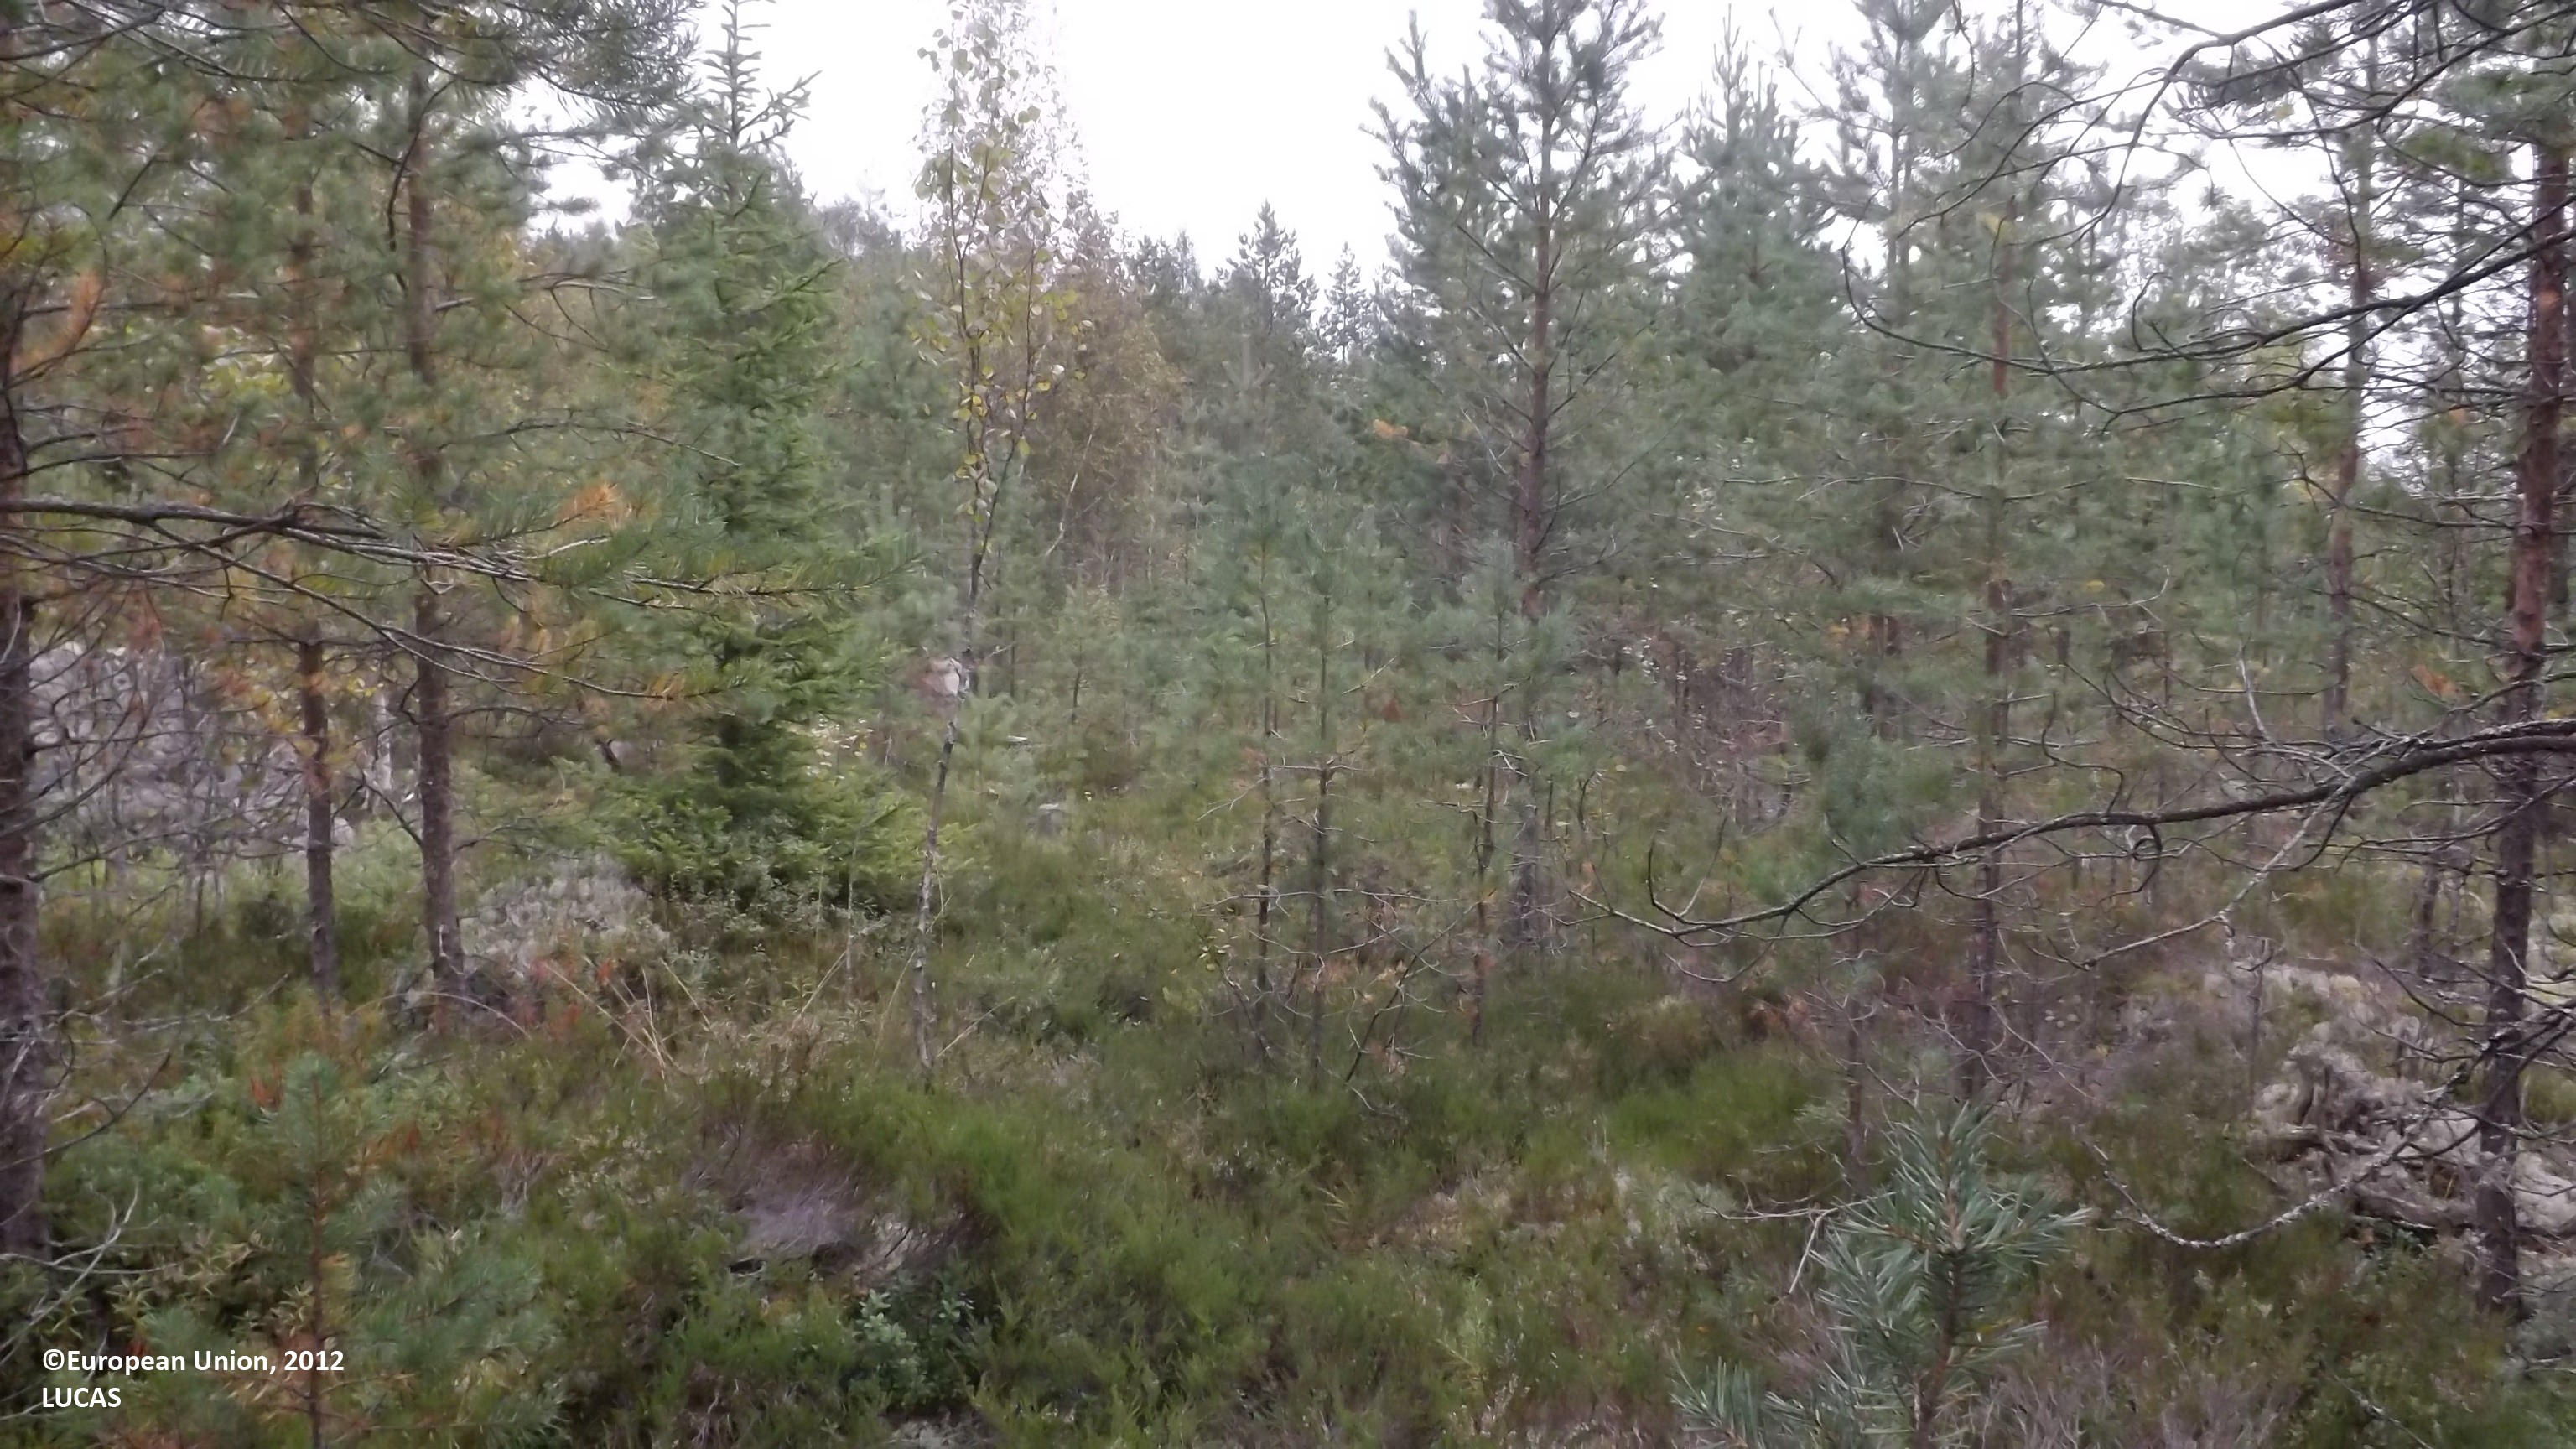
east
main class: Woodland
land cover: Pine dominated mixed woodland
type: boreal forest
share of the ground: 50 - 75 %
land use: Forestry
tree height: > 5 m
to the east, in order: Pine dominated mixed woodland; Other mixed woodland; Pine dominated mixed woodland; Other mixed woodland; Pine dominated mixed woodland; Ditches and canals; Broadleaved woodland; Pine dominated mixed woodland; Rivers and streams; Pine dominated mixed woodland
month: August
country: FI
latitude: 63.7734
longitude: 24.0014
